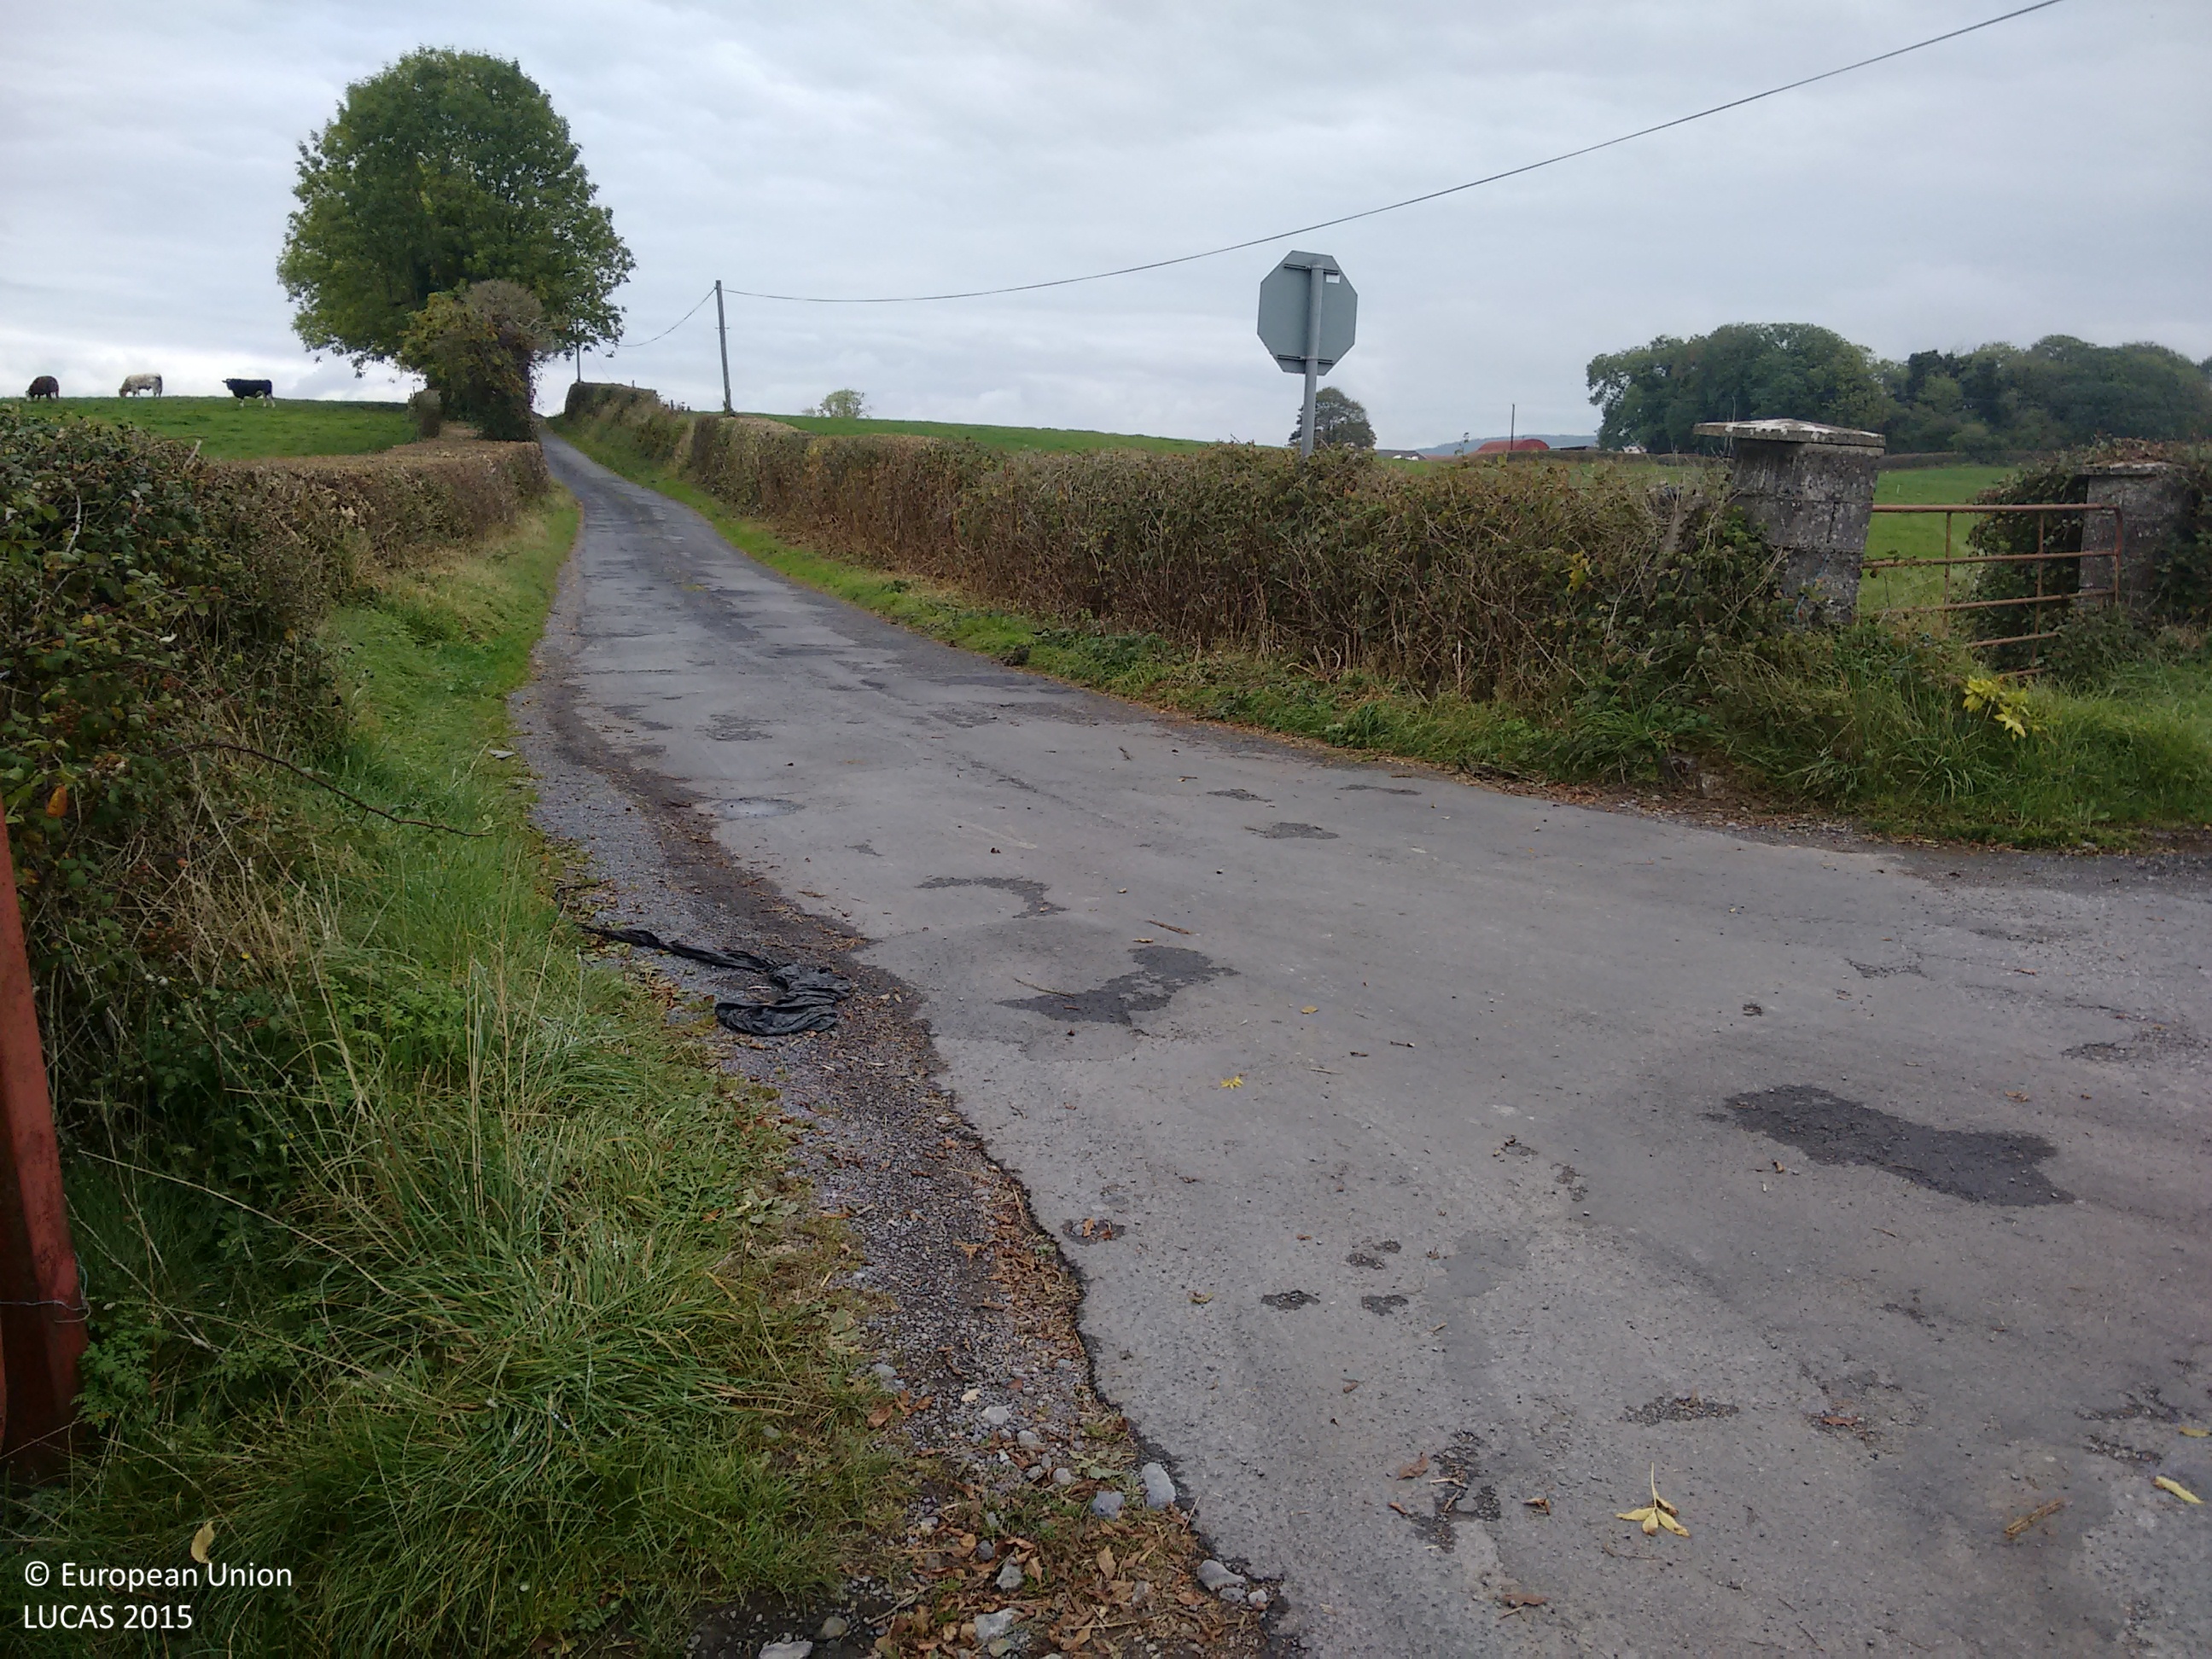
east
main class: Grassland
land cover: Grassland without tree/shrub cover
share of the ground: > 75 %
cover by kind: herbaceous plants 95 %
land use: Agriculture (excluding fallow land and kitchen gardens)
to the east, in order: Grassland without tree/shrub cover; Fences; Managed hedges; Paved roads, cycling and walking lanes; Managed hedges; Fences; Electric lines; Grassland without tree/shrub cover; Fences; Managed hedges; Fences; Grassland without tree/shrub cover; Electric lines; Grassland without tree/shrub cover; Artificial constructions in urban areas
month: October
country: IE
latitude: 52.8125
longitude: -7.5025
